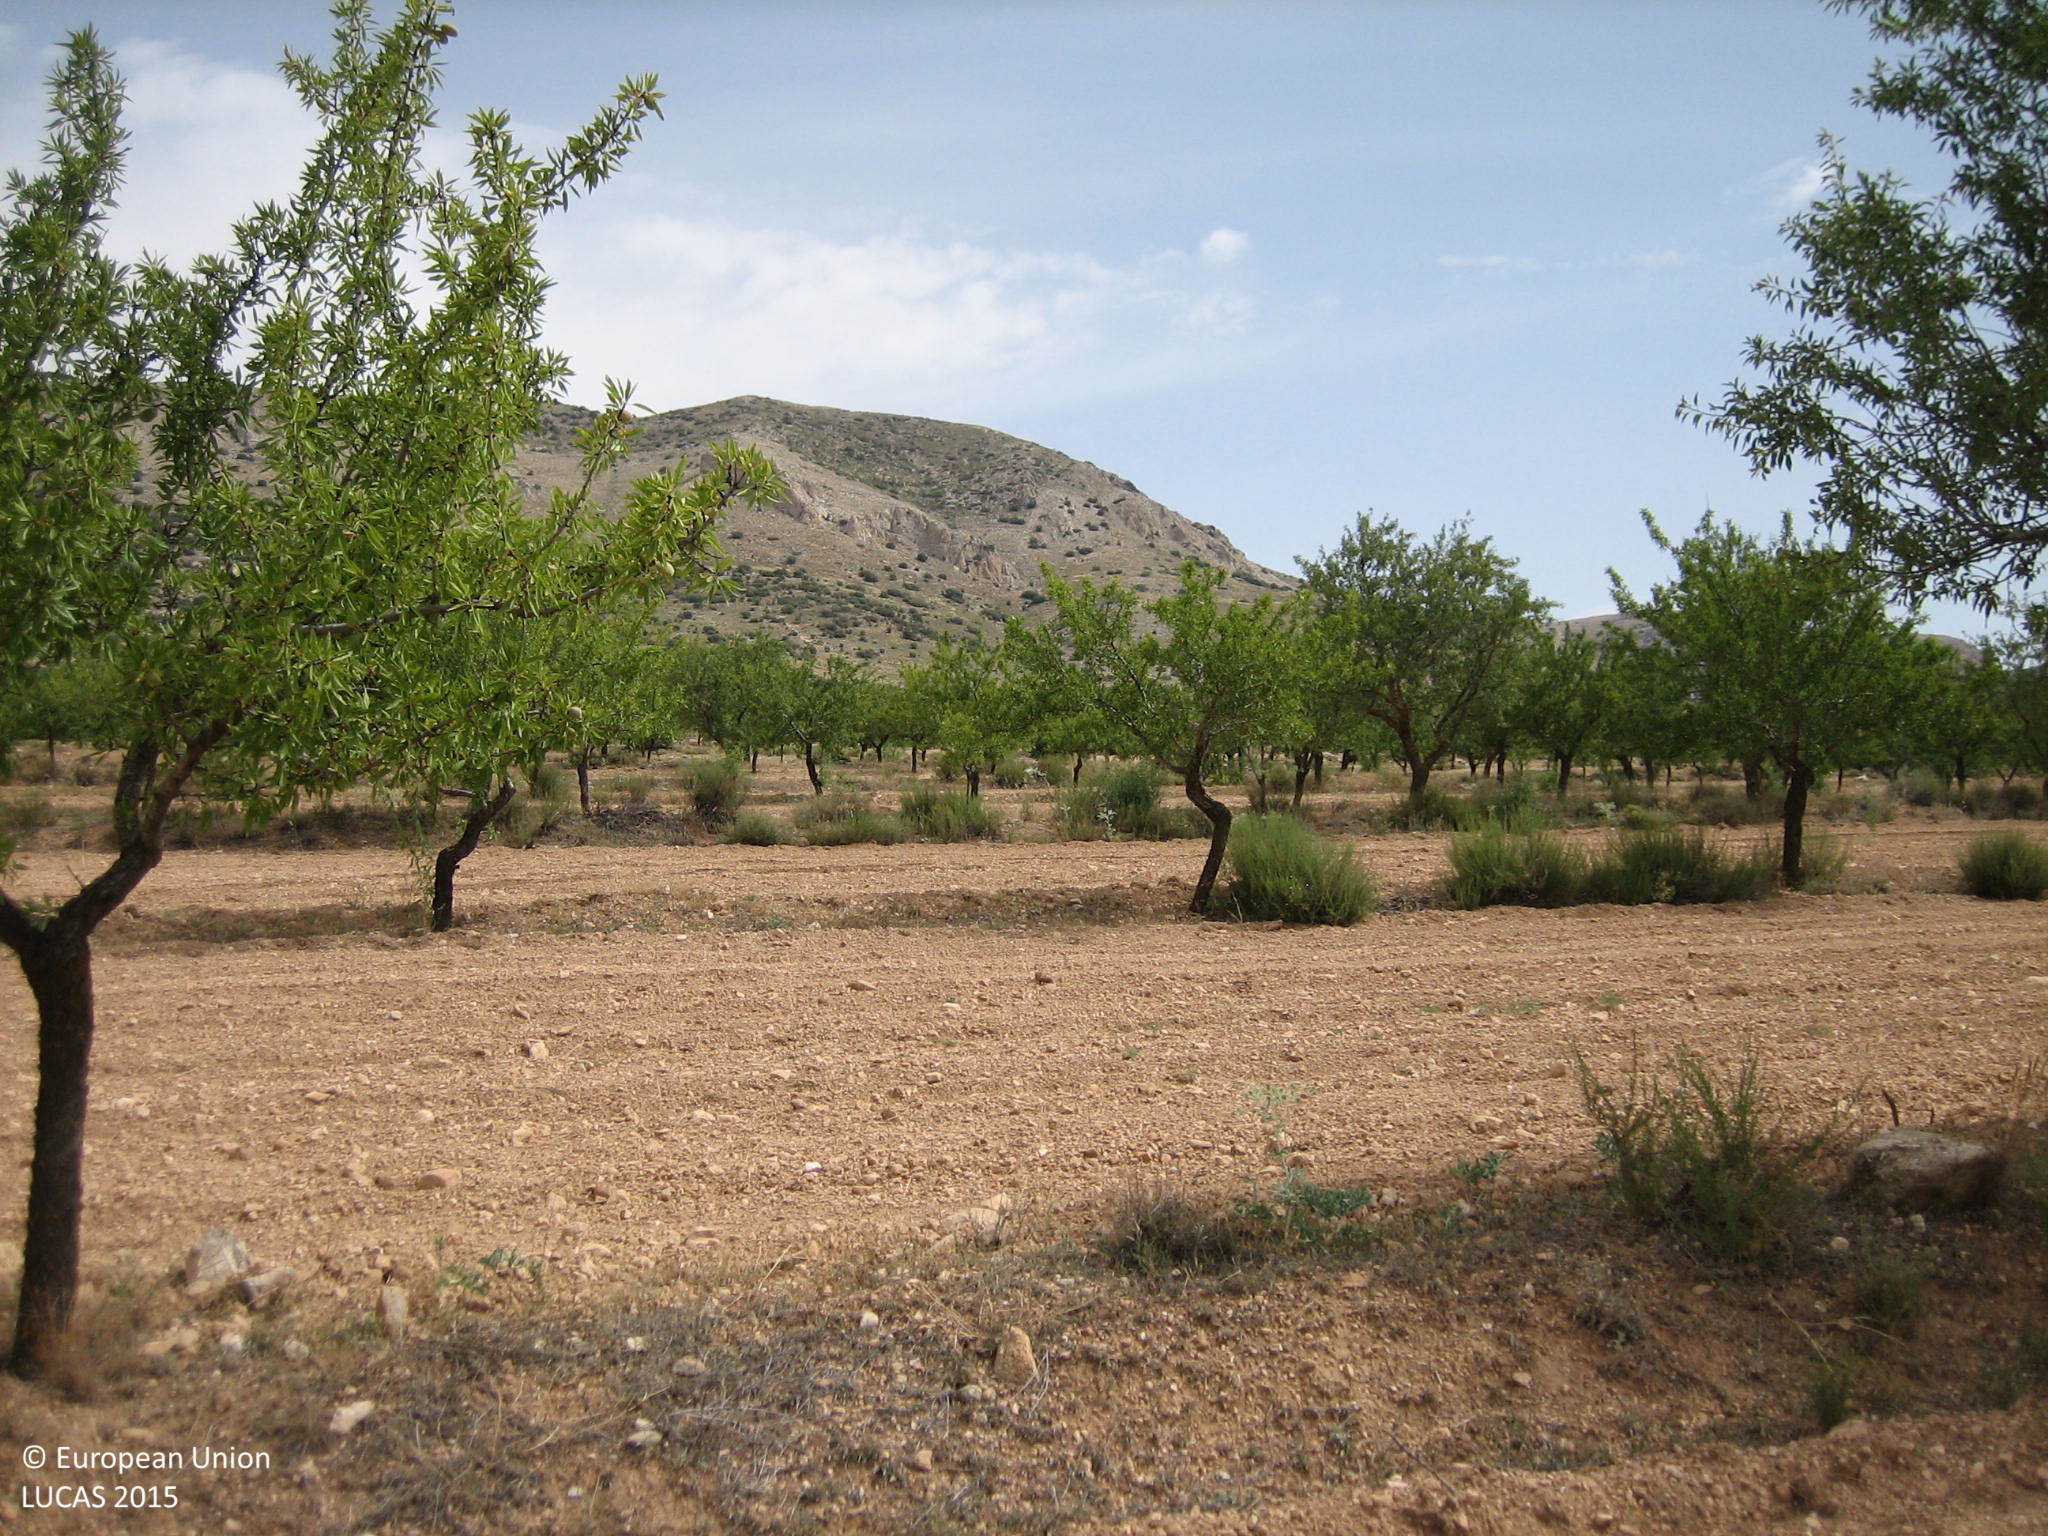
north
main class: Cropland
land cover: Nuts trees
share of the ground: < 10 %
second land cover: Other bare soil
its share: > 75 %
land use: Agriculture (excluding fallow land and kitchen gardens)
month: July
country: ES
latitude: 37.6027
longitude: -2.3206
